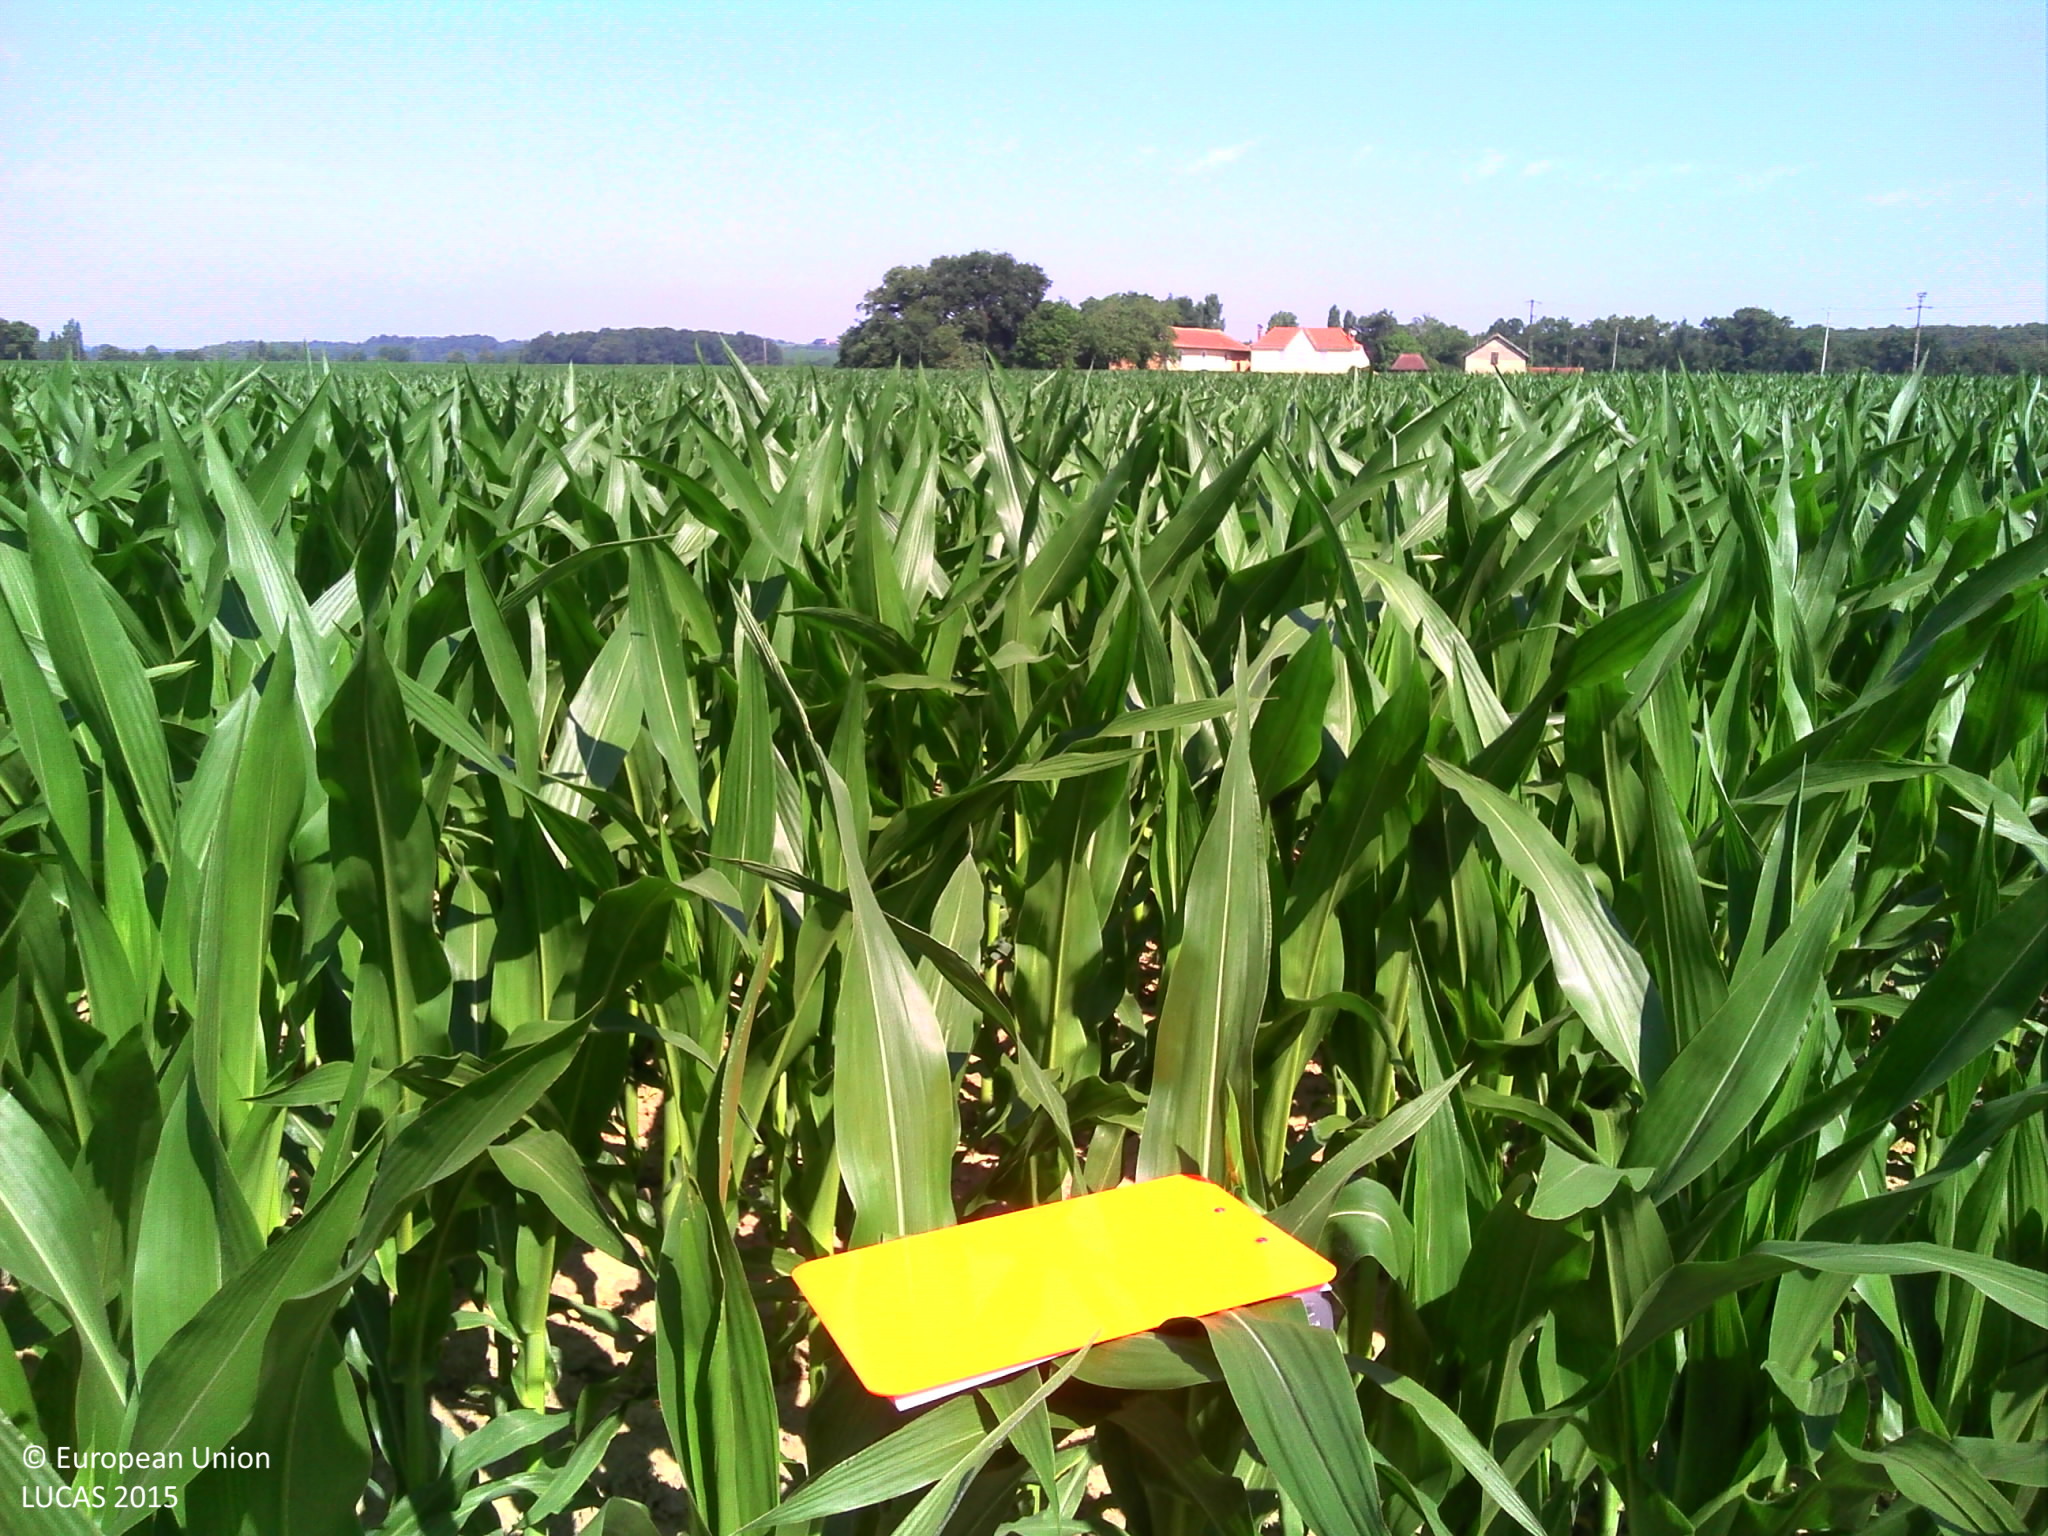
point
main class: Cropland
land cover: Maize
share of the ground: > 75 %
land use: Agriculture (excluding fallow land and kitchen gardens)
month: June
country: FR
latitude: 43.5777
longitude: -0.5234
